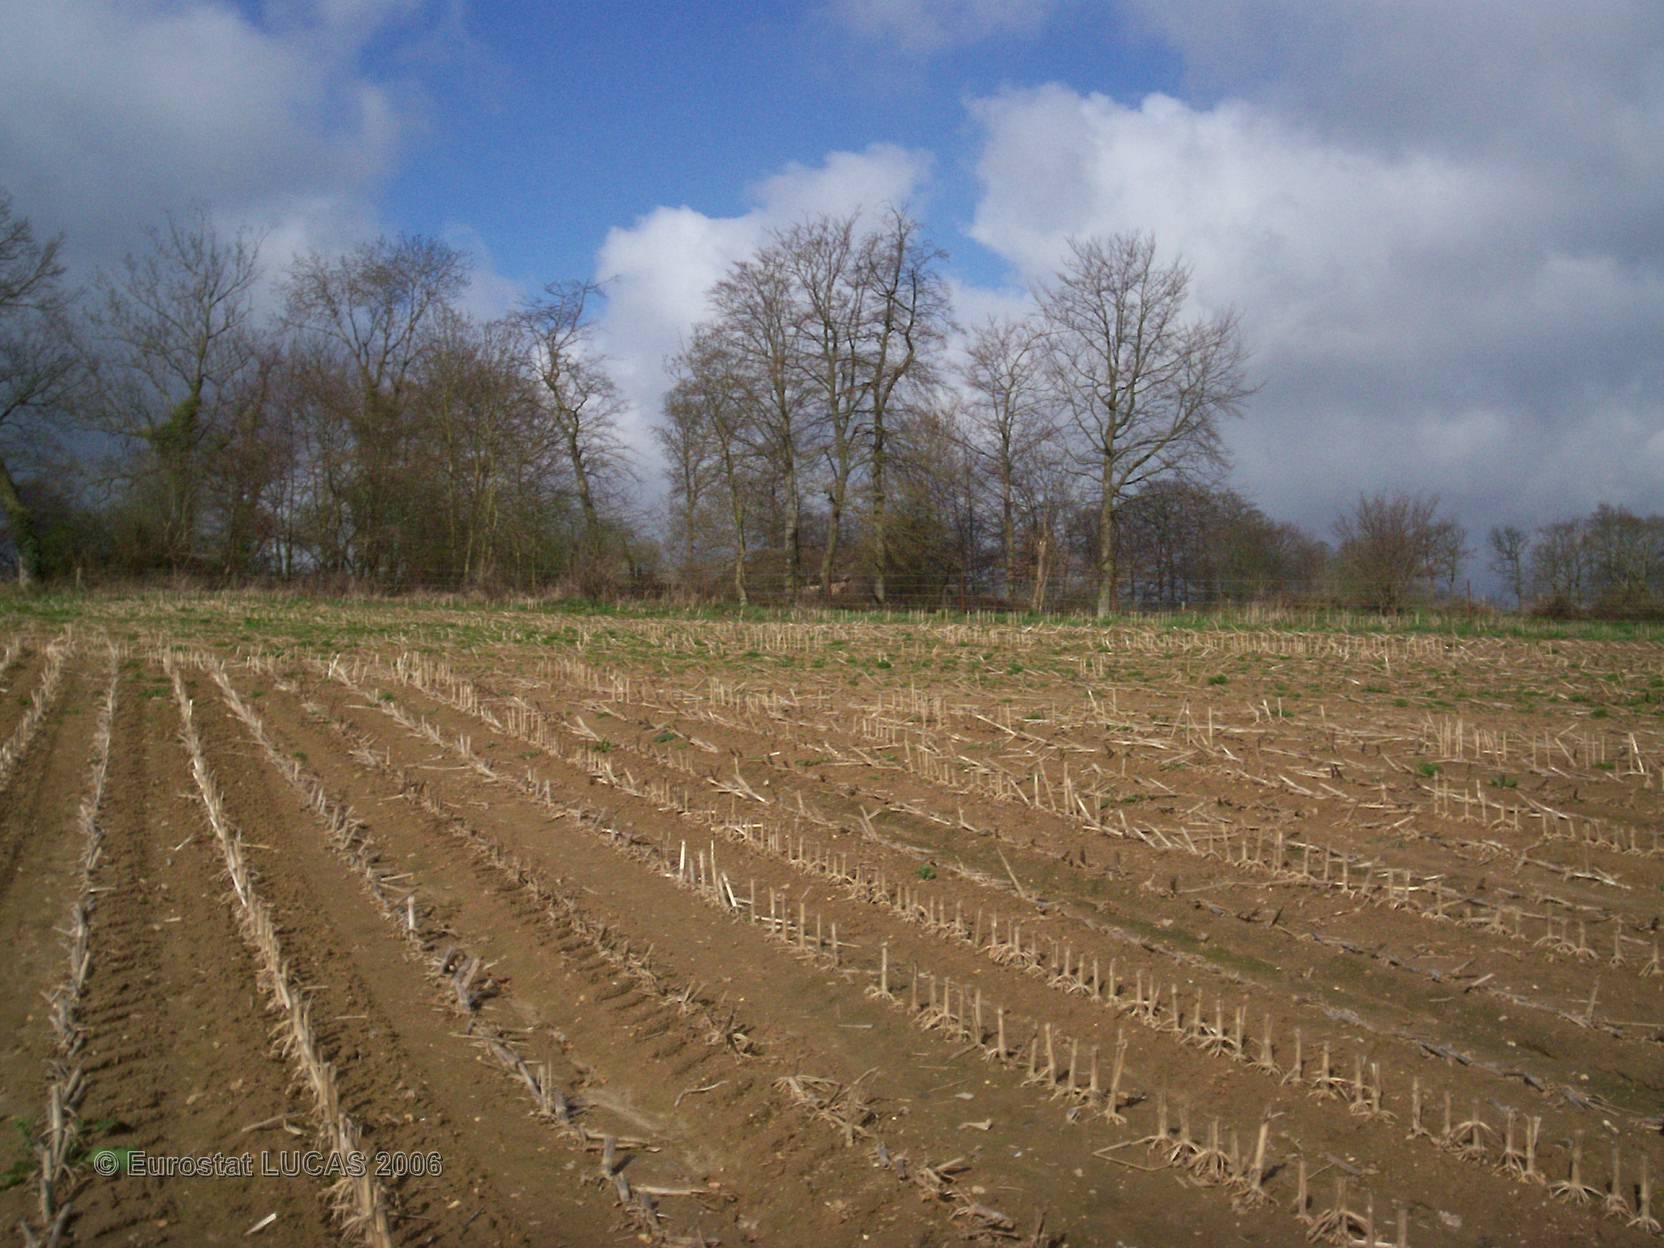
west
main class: Cropland
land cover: Maize
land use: Agriculture (excluding fallow land and kitchen gardens)
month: May
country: FR
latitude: 49.7395
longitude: 0.8037
